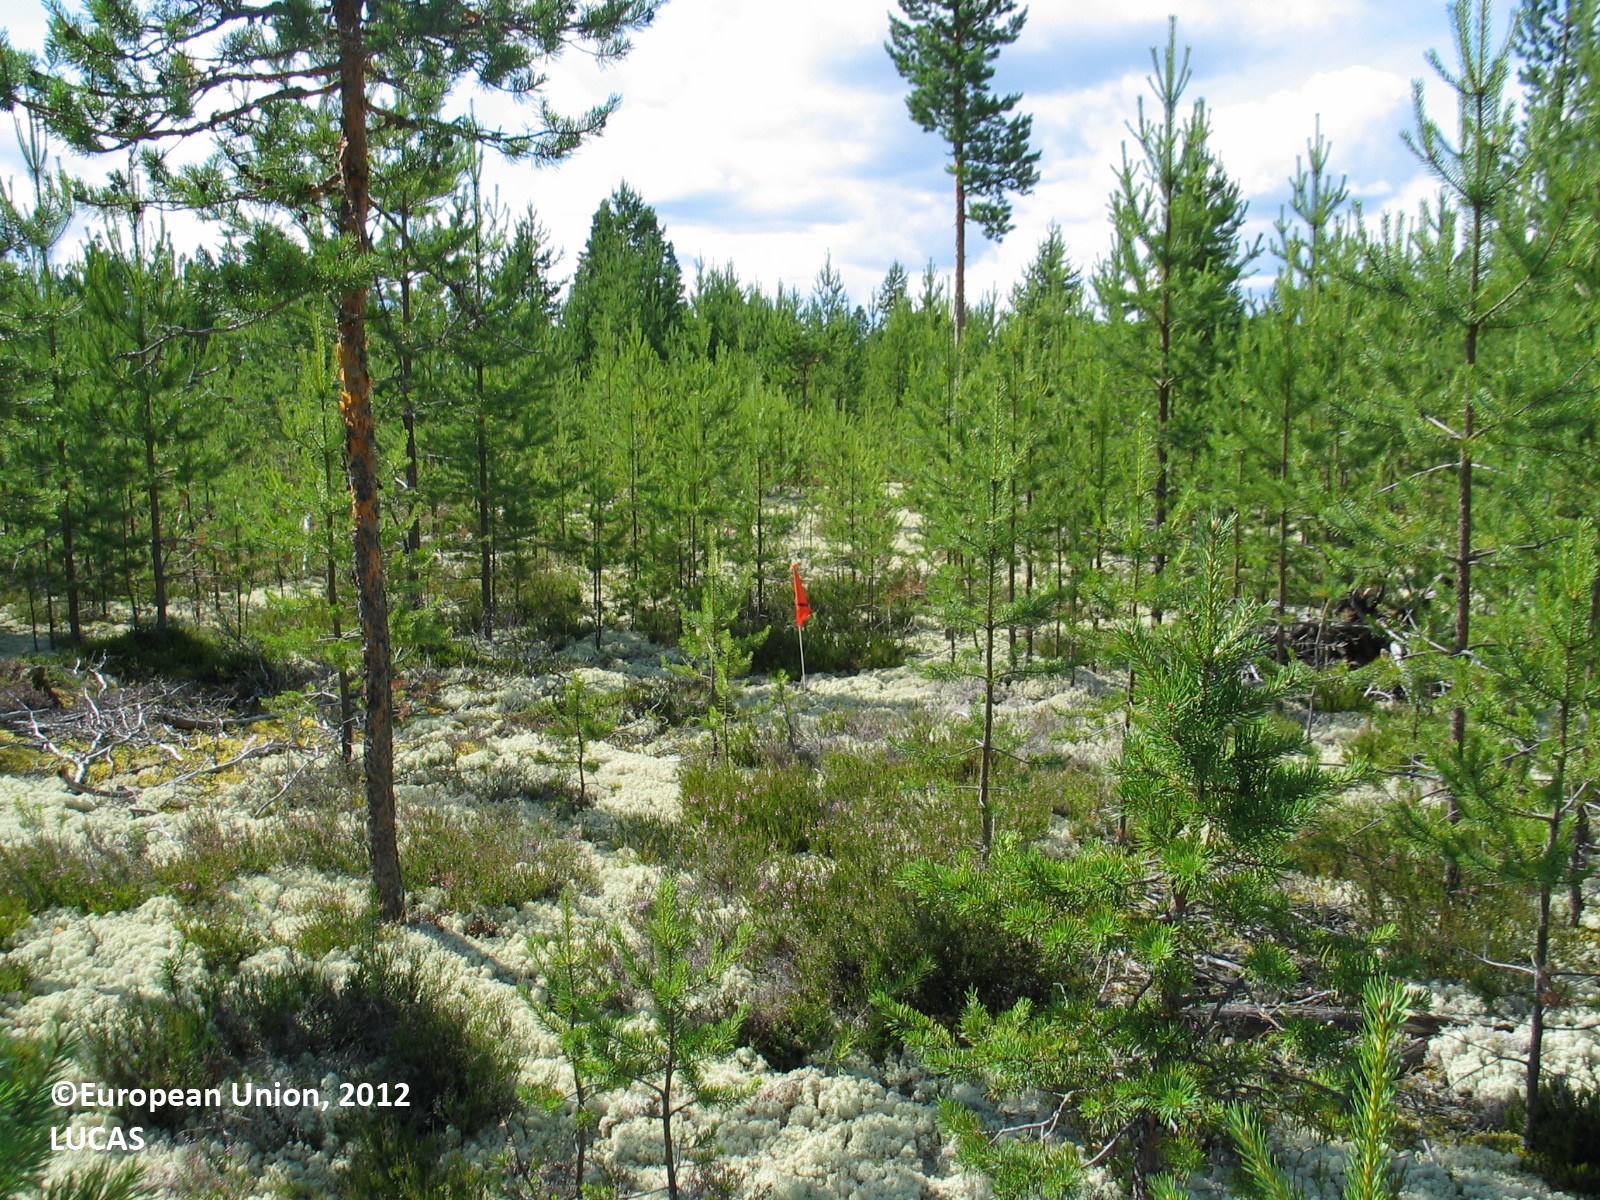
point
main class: Woodland
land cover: Pine dominated coniferous woodland
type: boreal forest
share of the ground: 25 - 50 %
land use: Forestry
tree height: > 5 m
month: July
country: FI
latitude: 64.6077
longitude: 26.4350
